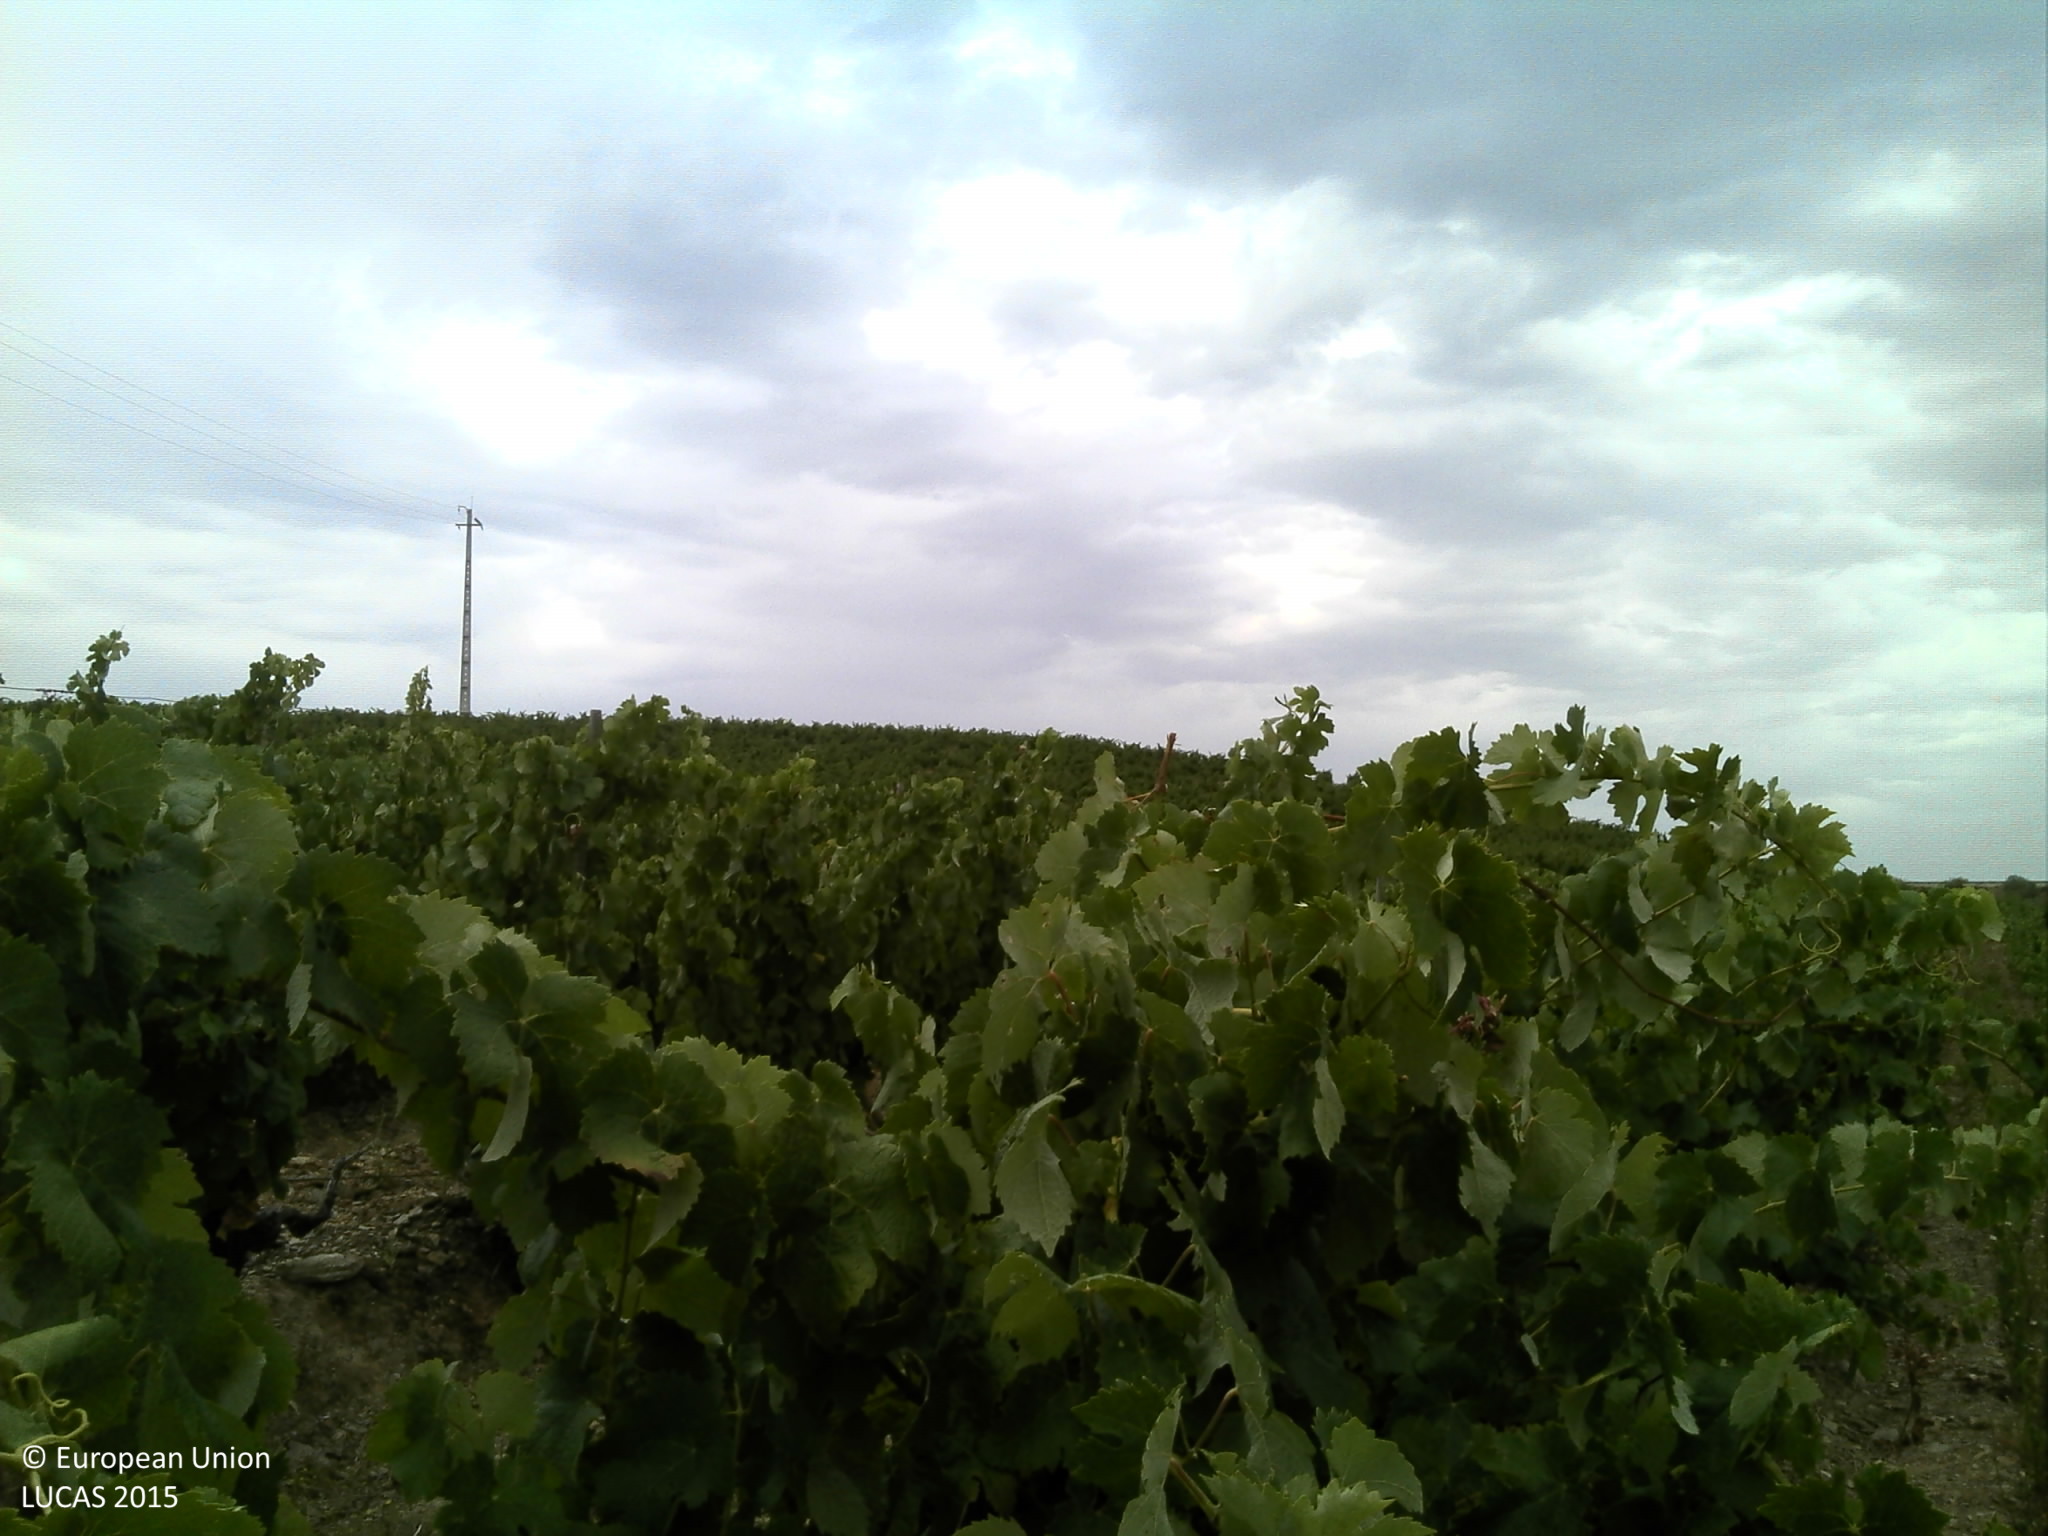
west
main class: Cropland
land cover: Vineyards
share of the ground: 25 - 50 %
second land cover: Other bare soil
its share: > 75 %
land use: Agriculture (excluding fallow land and kitchen gardens)
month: July
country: PT
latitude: 38.8215
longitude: -7.4364
